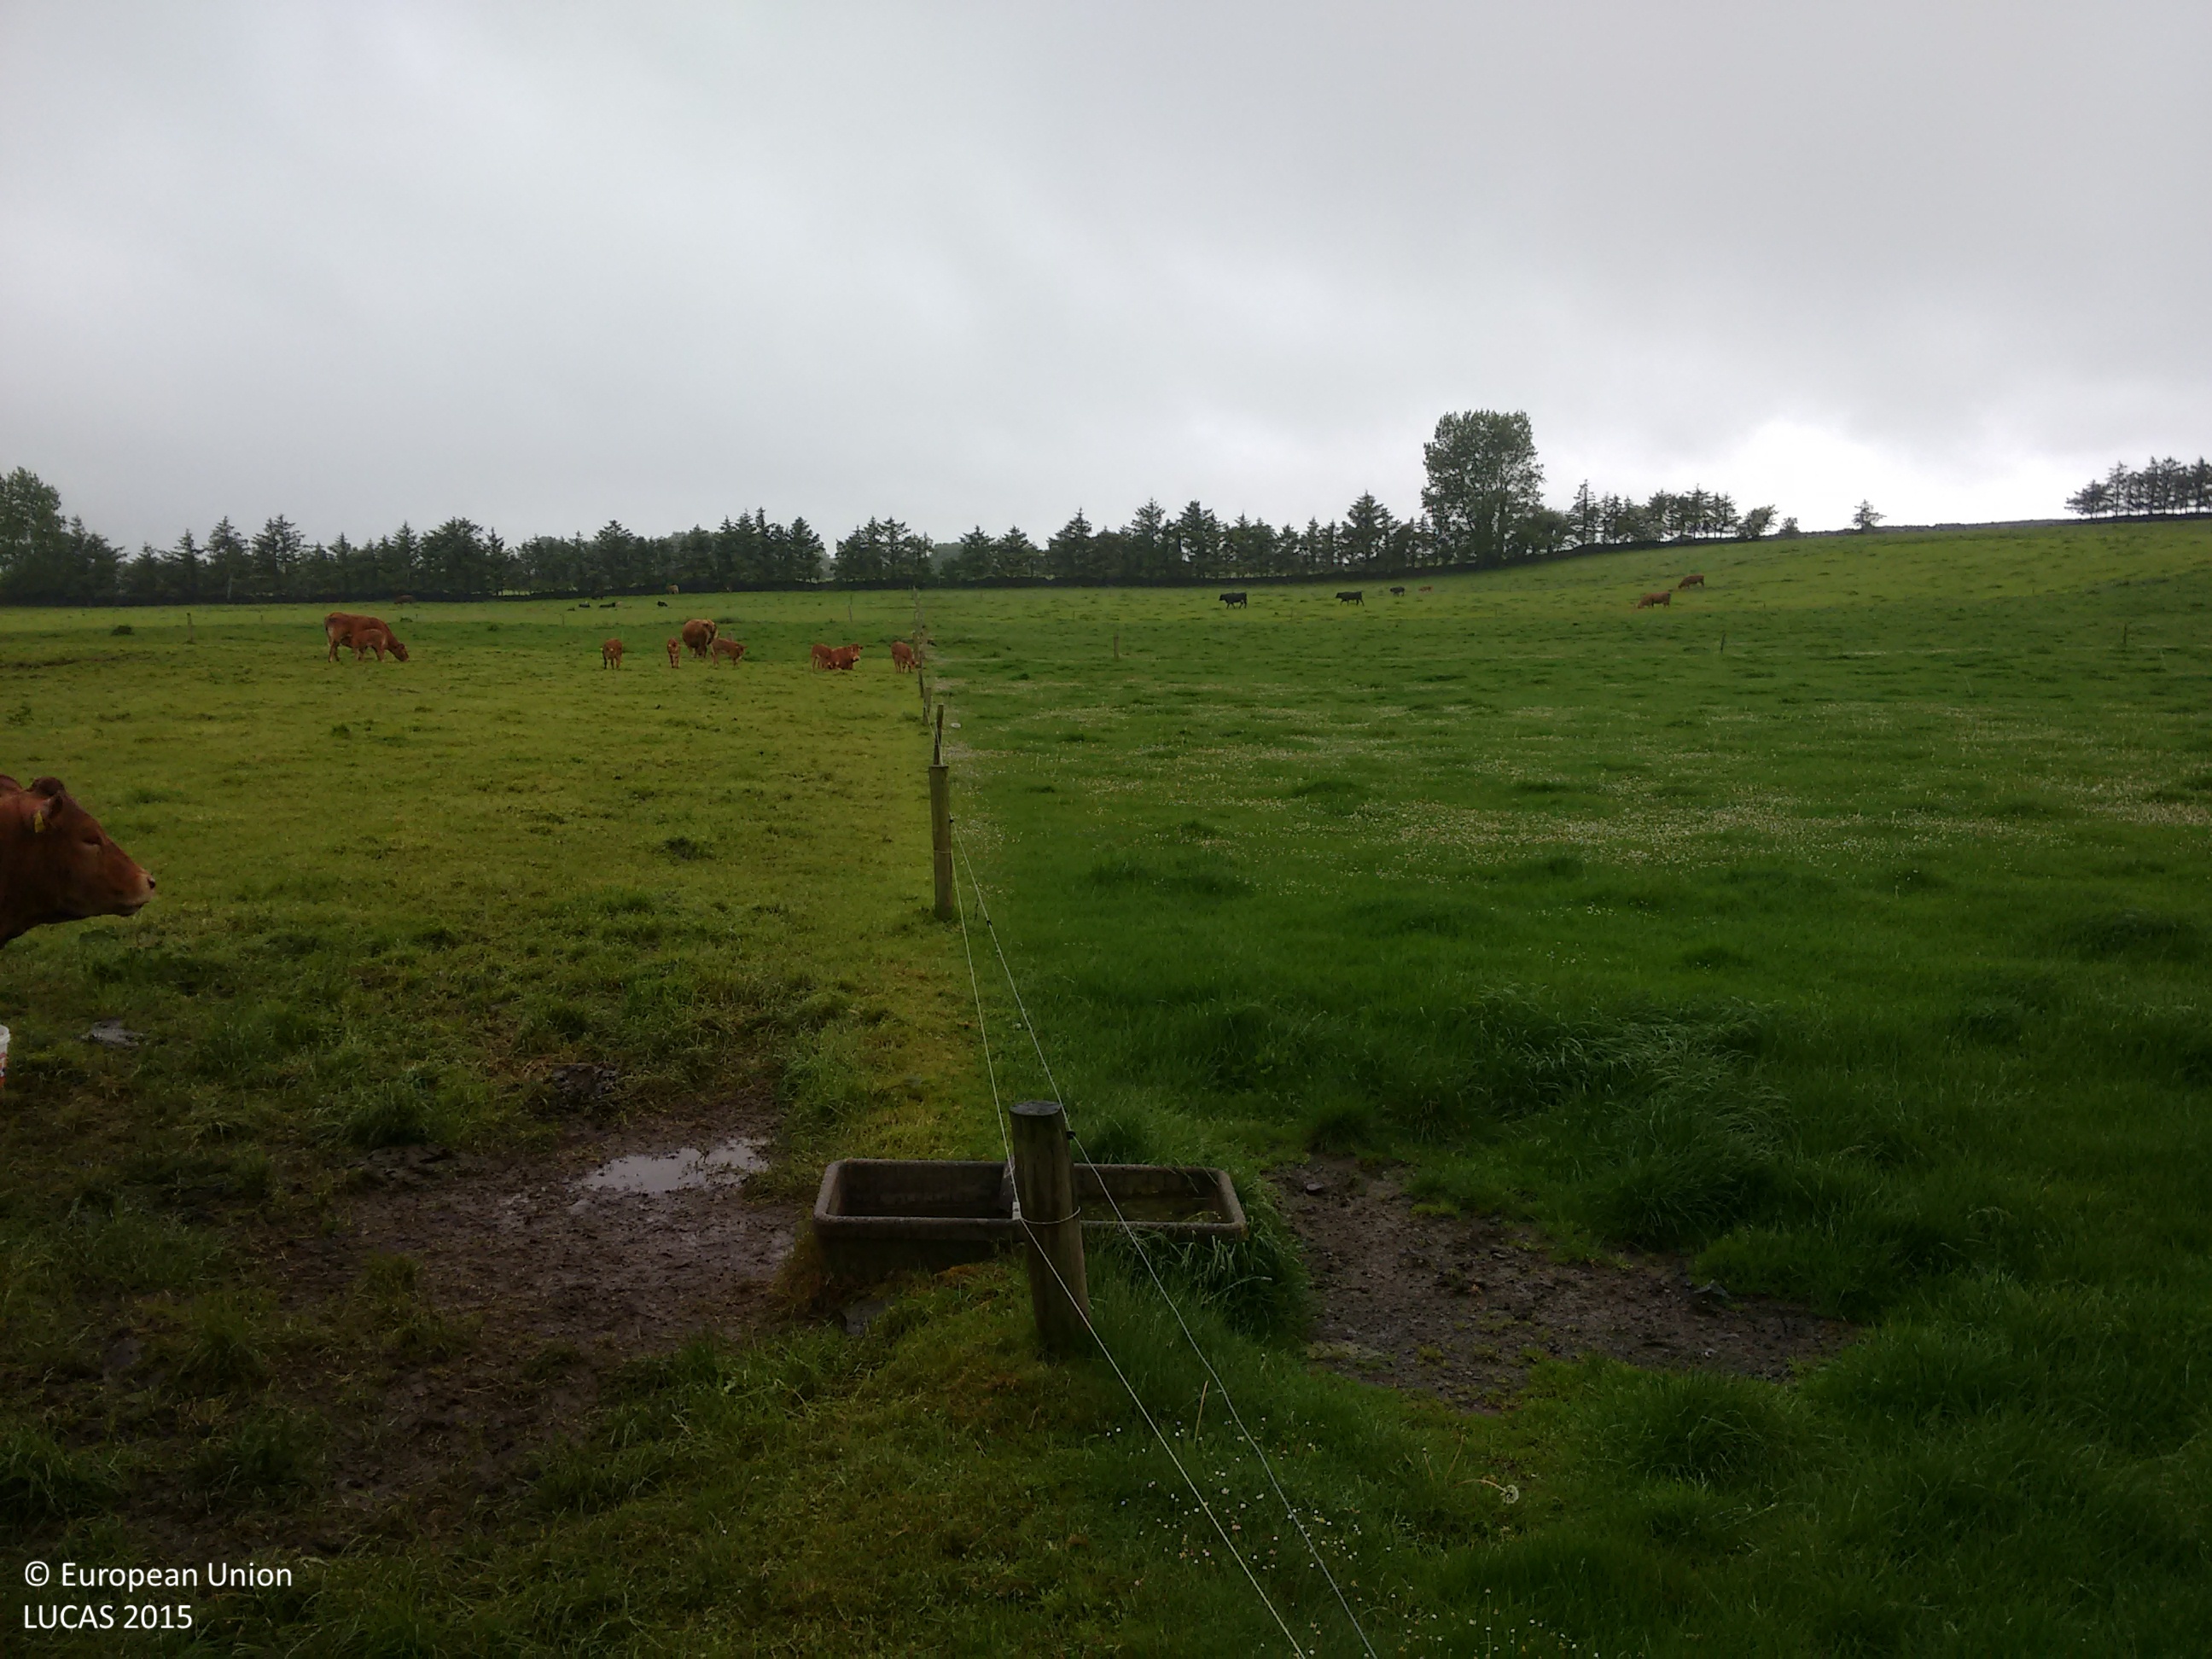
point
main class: Grassland
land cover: Grassland without tree/shrub cover
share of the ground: > 75 %
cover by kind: herbaceous plants 100 %
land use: Agriculture (excluding fallow land and kitchen gardens)
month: May
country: IE
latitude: 53.1108
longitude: -8.8041
